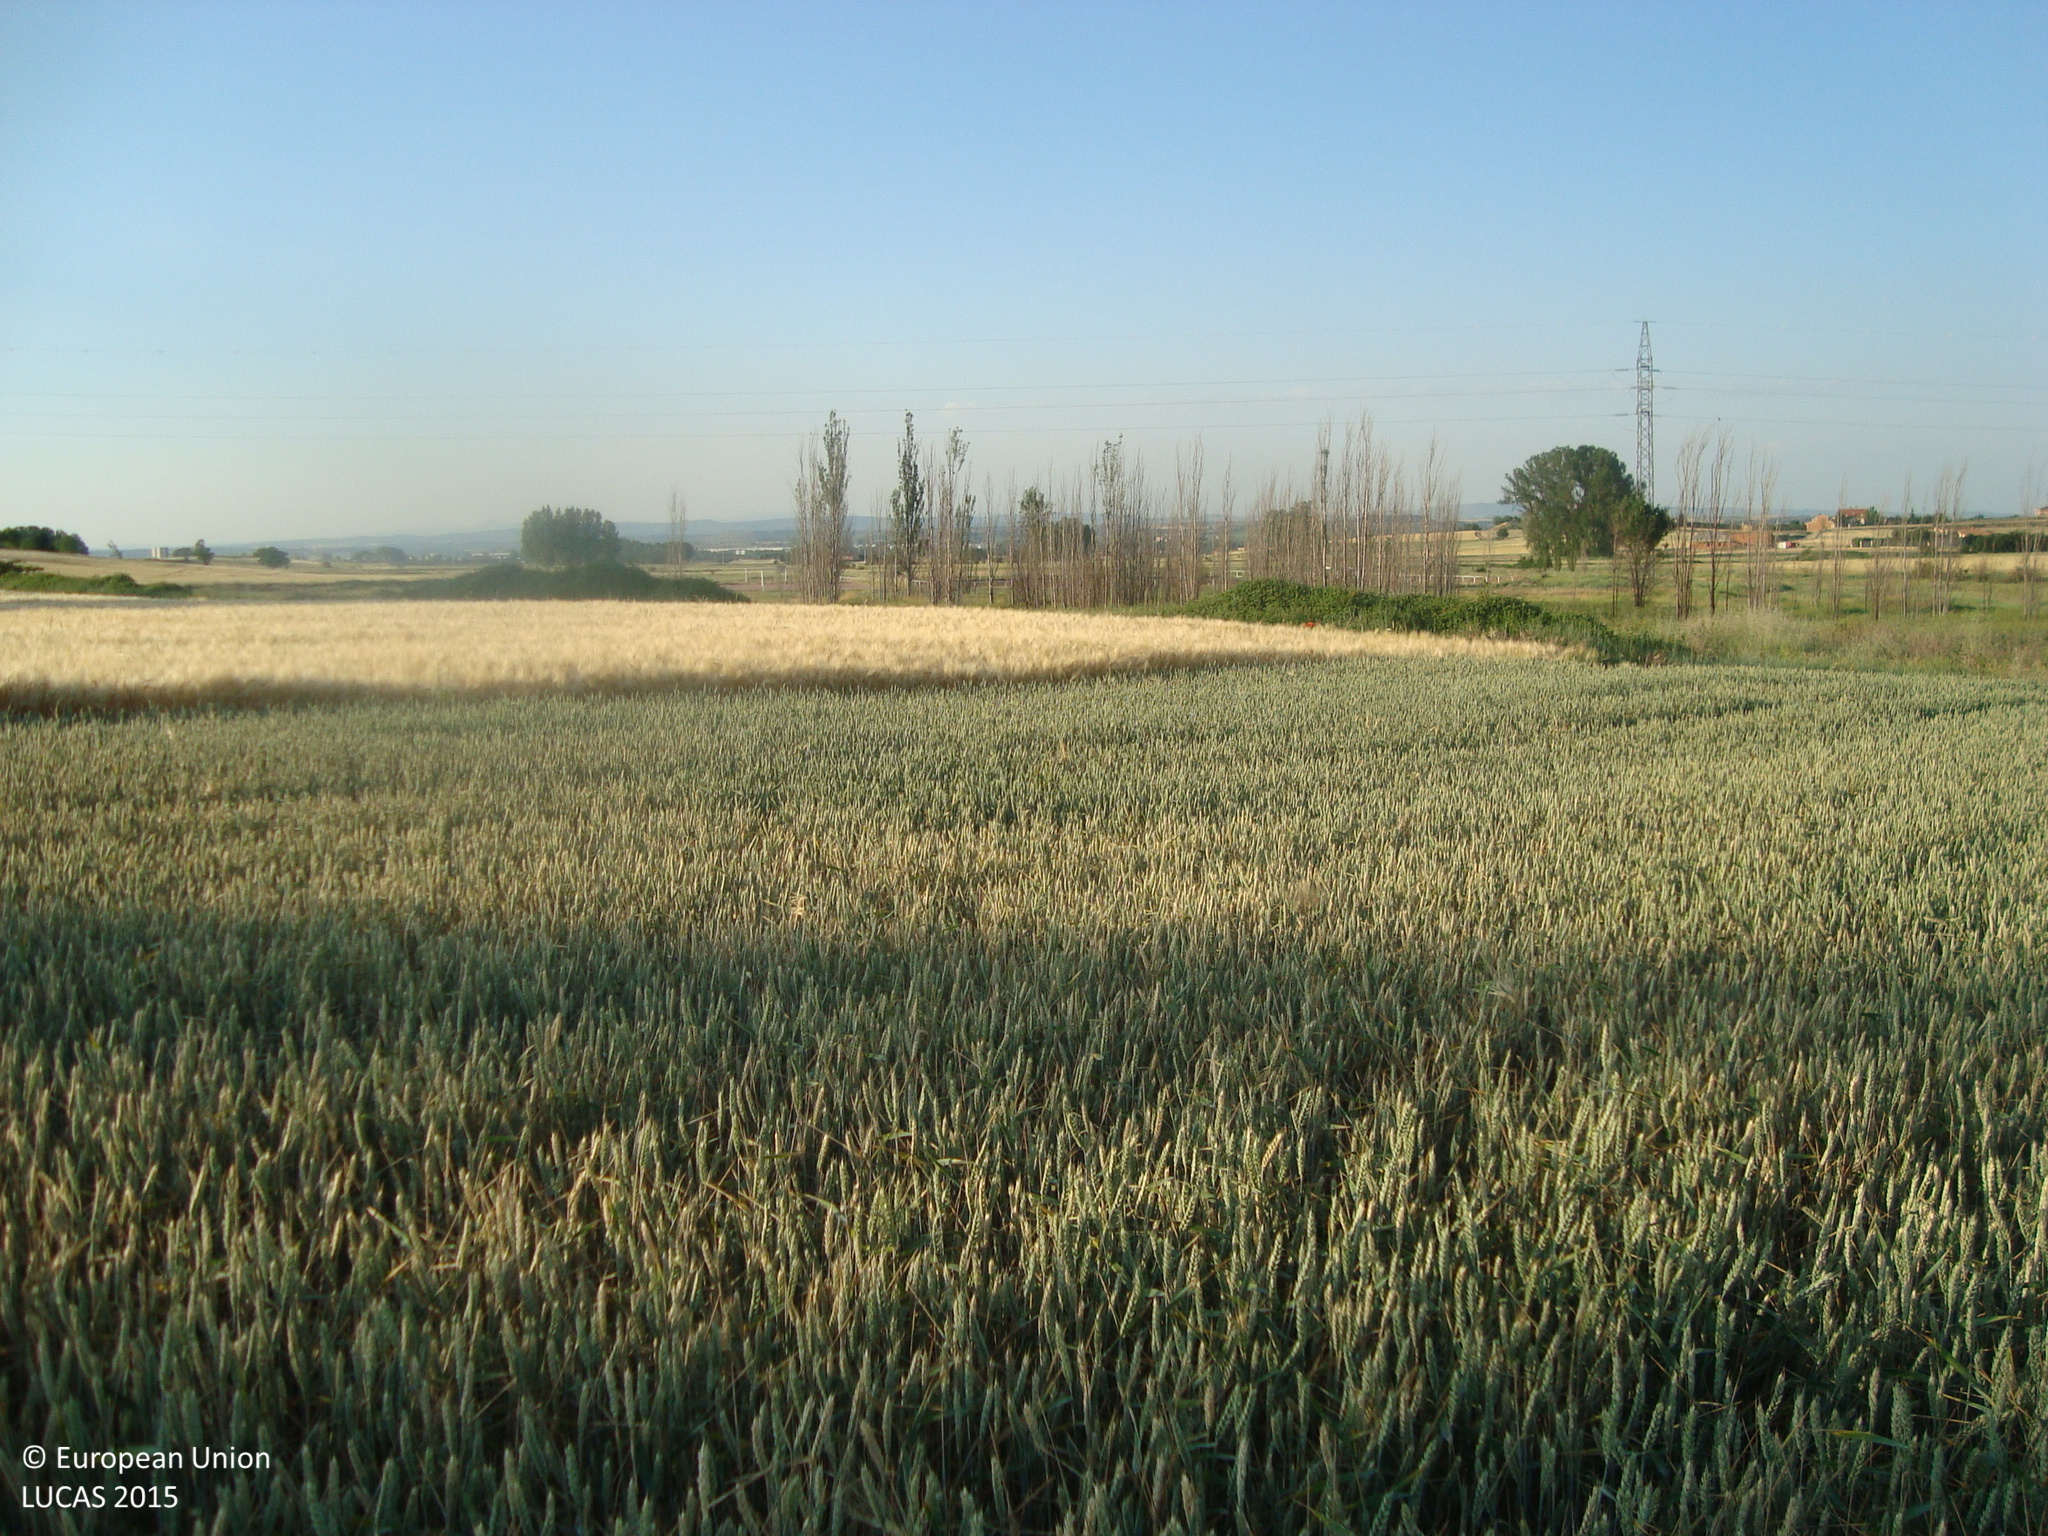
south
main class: Cropland
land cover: Common wheat
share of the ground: > 75 %
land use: Agriculture (excluding fallow land and kitchen gardens)
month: June
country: ES
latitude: 41.6944
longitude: -3.7394
